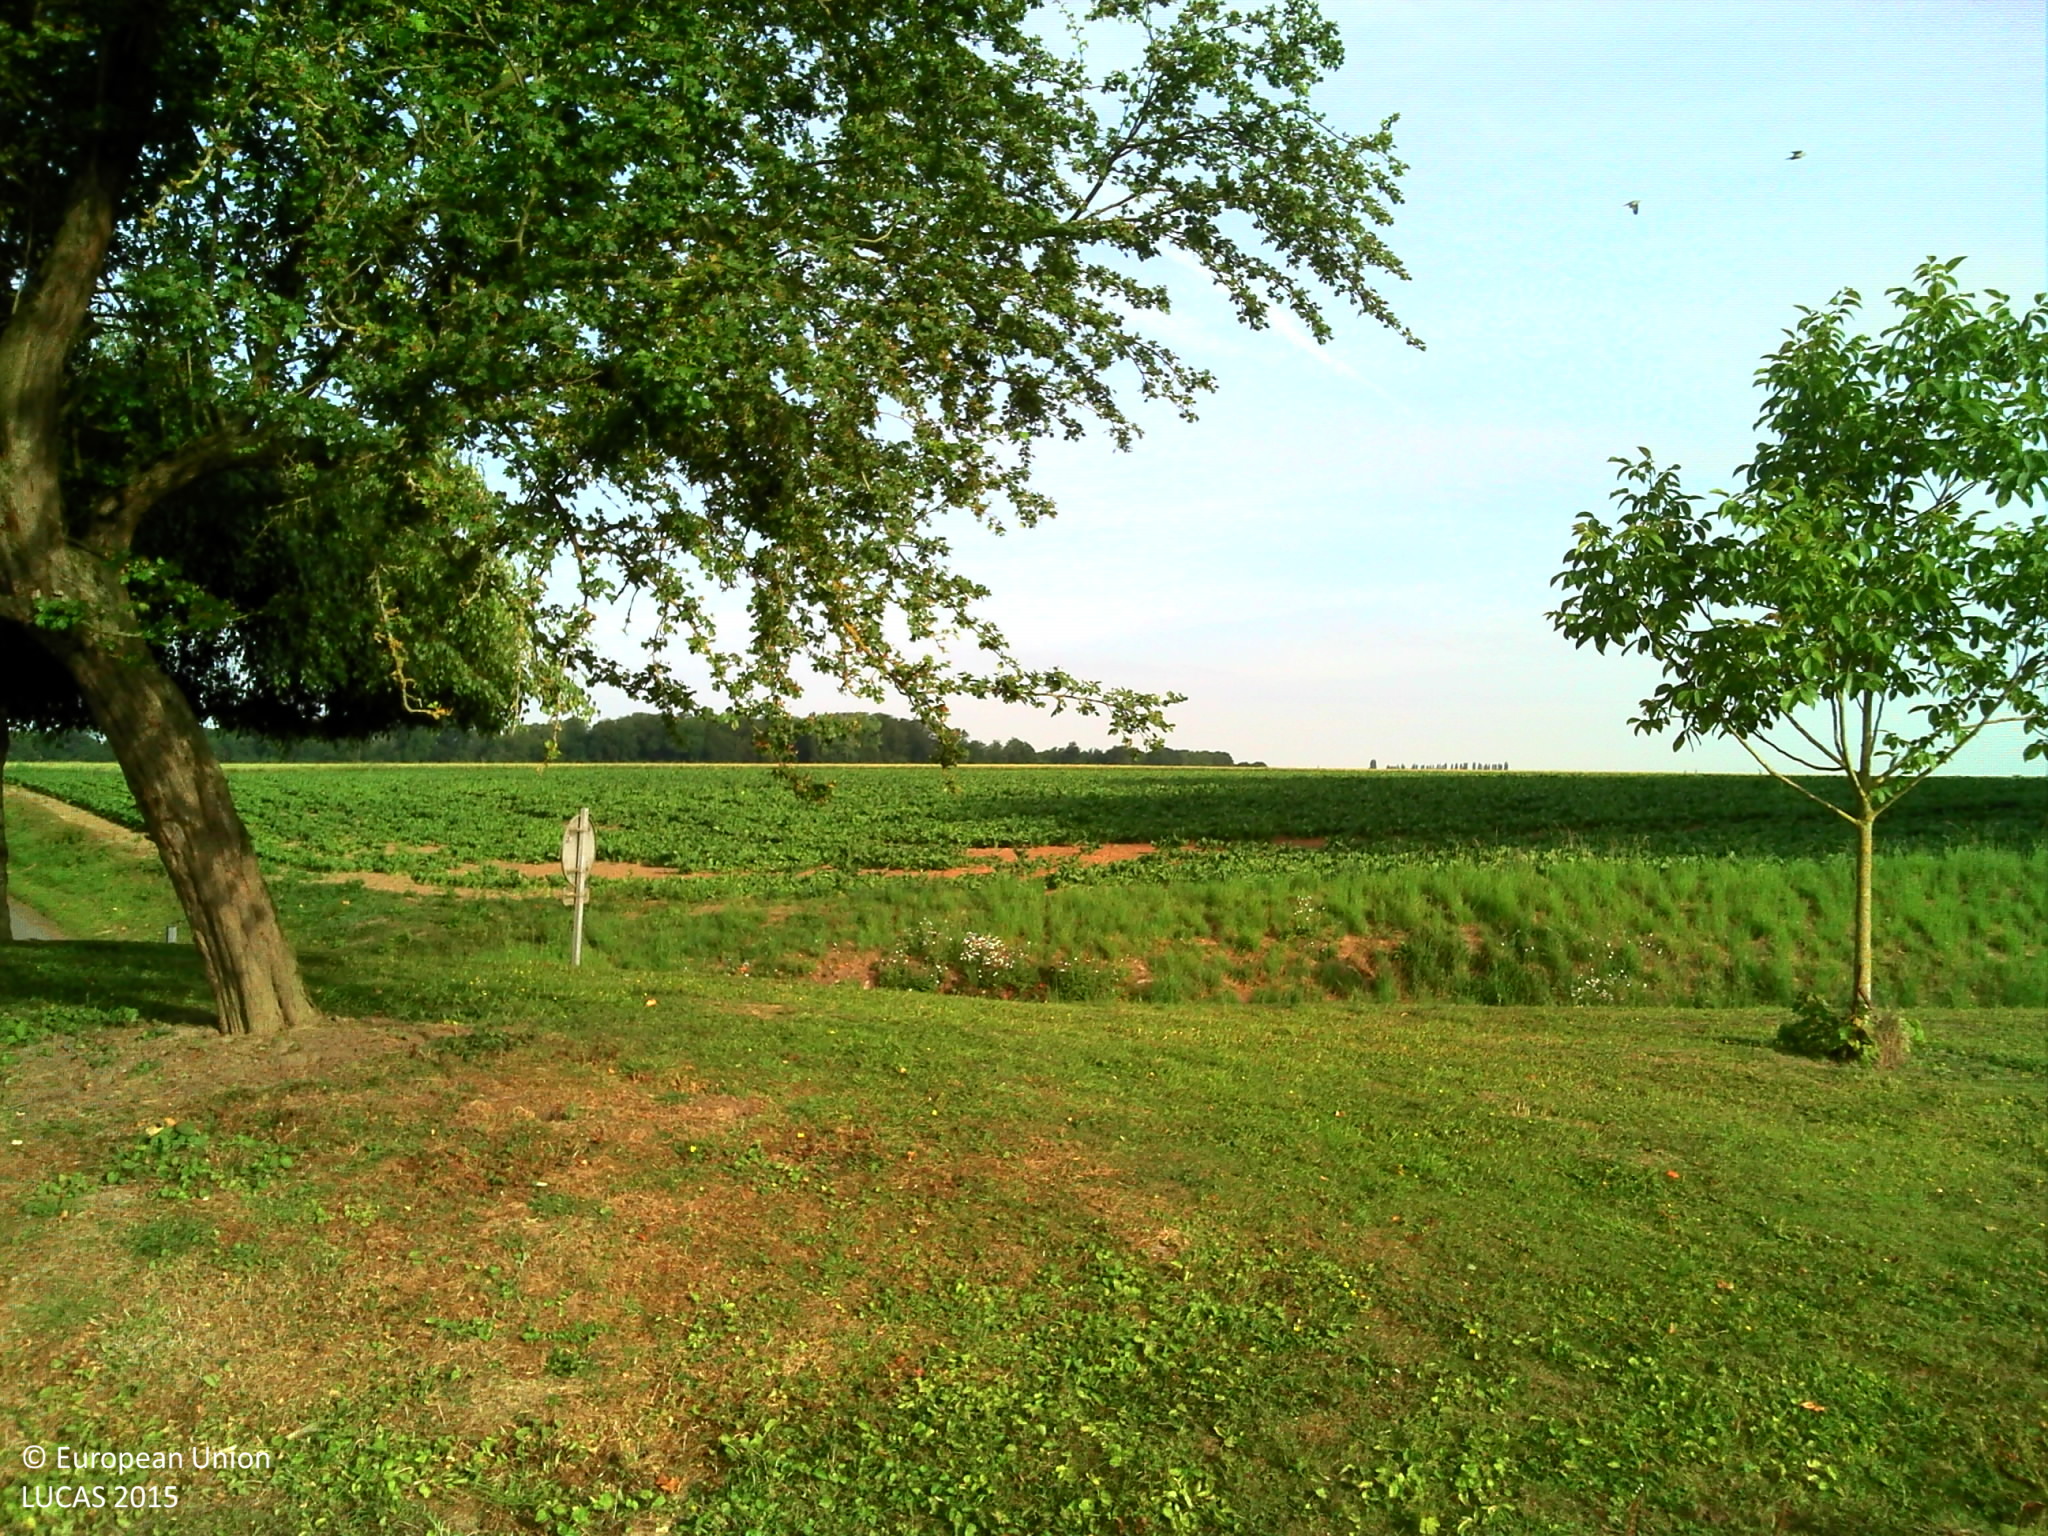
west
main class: Cropland
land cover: Maize
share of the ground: 50 - 75 %
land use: Agriculture (excluding fallow land and kitchen gardens)
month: June
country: FR
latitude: 49.3850
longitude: 2.6188
